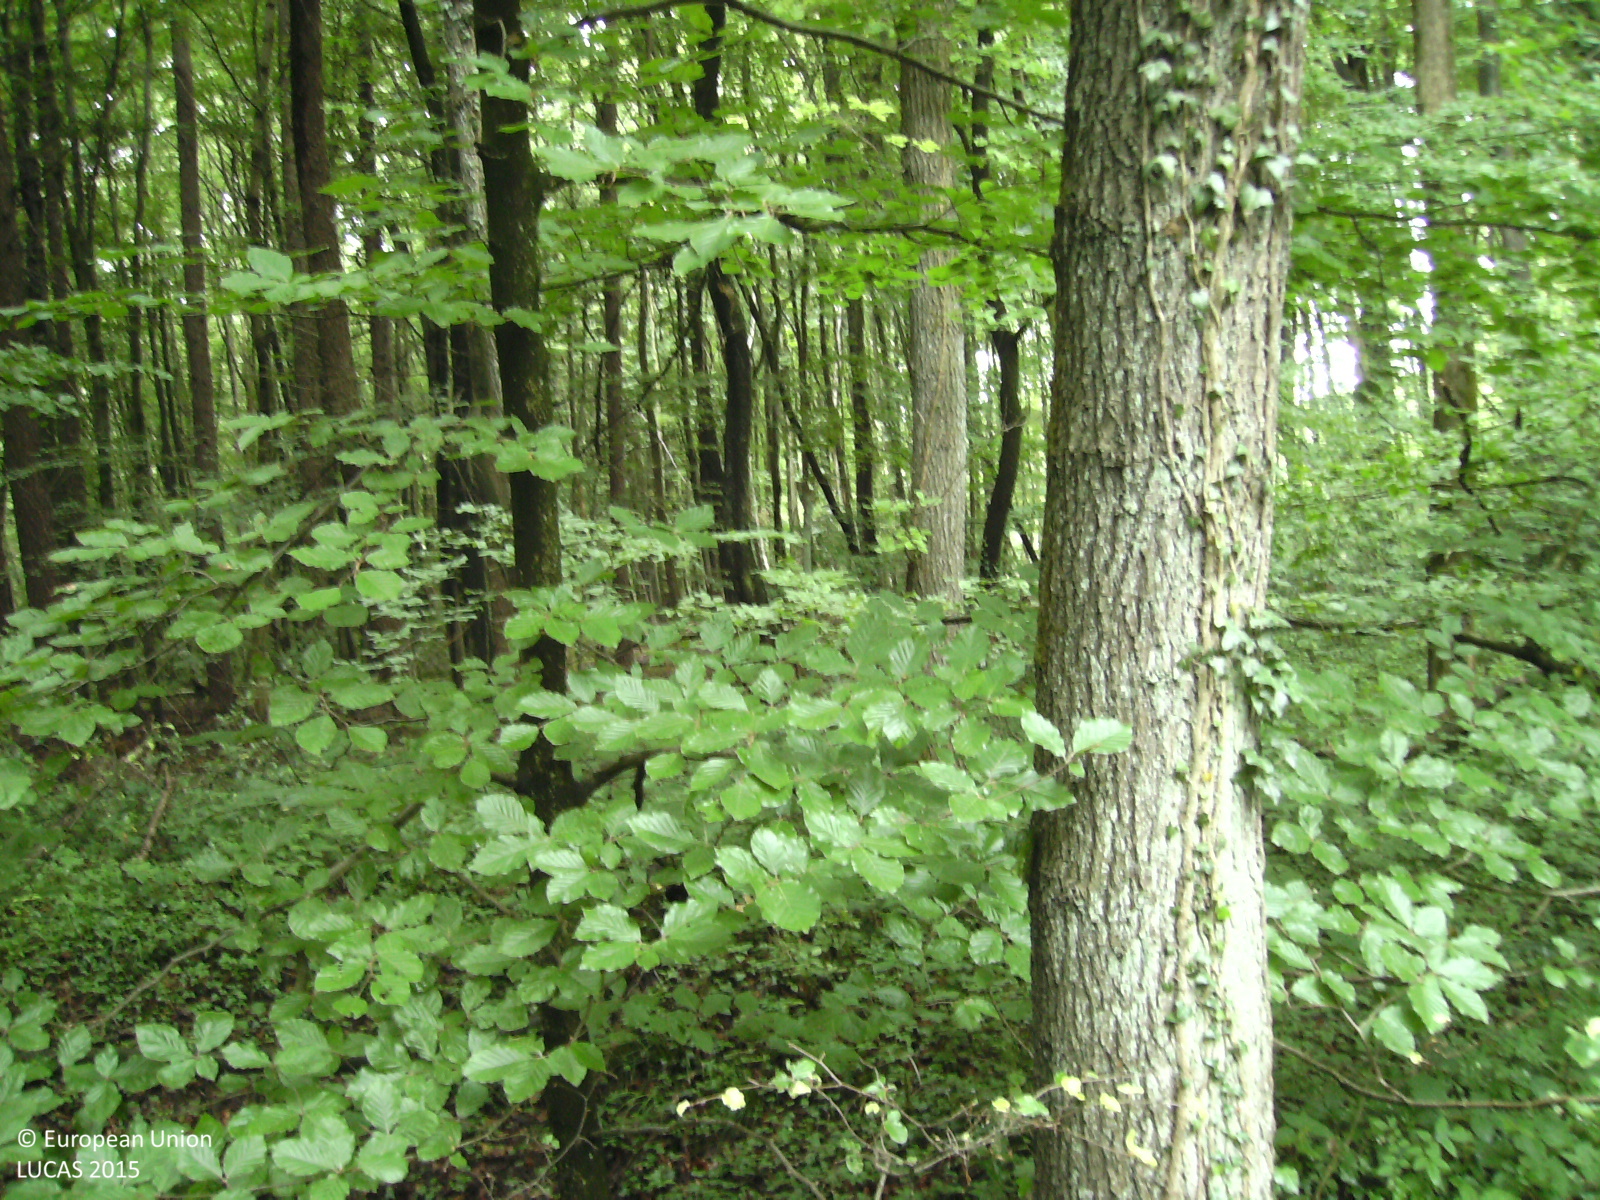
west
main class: Woodland
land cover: Broadleaved woodland
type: mesophytic deciduous forest
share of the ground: > 75 %
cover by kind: broadleaved forest trees 100 %
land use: Forestry
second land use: Amenities, museums, leisure
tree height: > 5 m
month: June
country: DE
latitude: 51.2253
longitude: 7.0359
